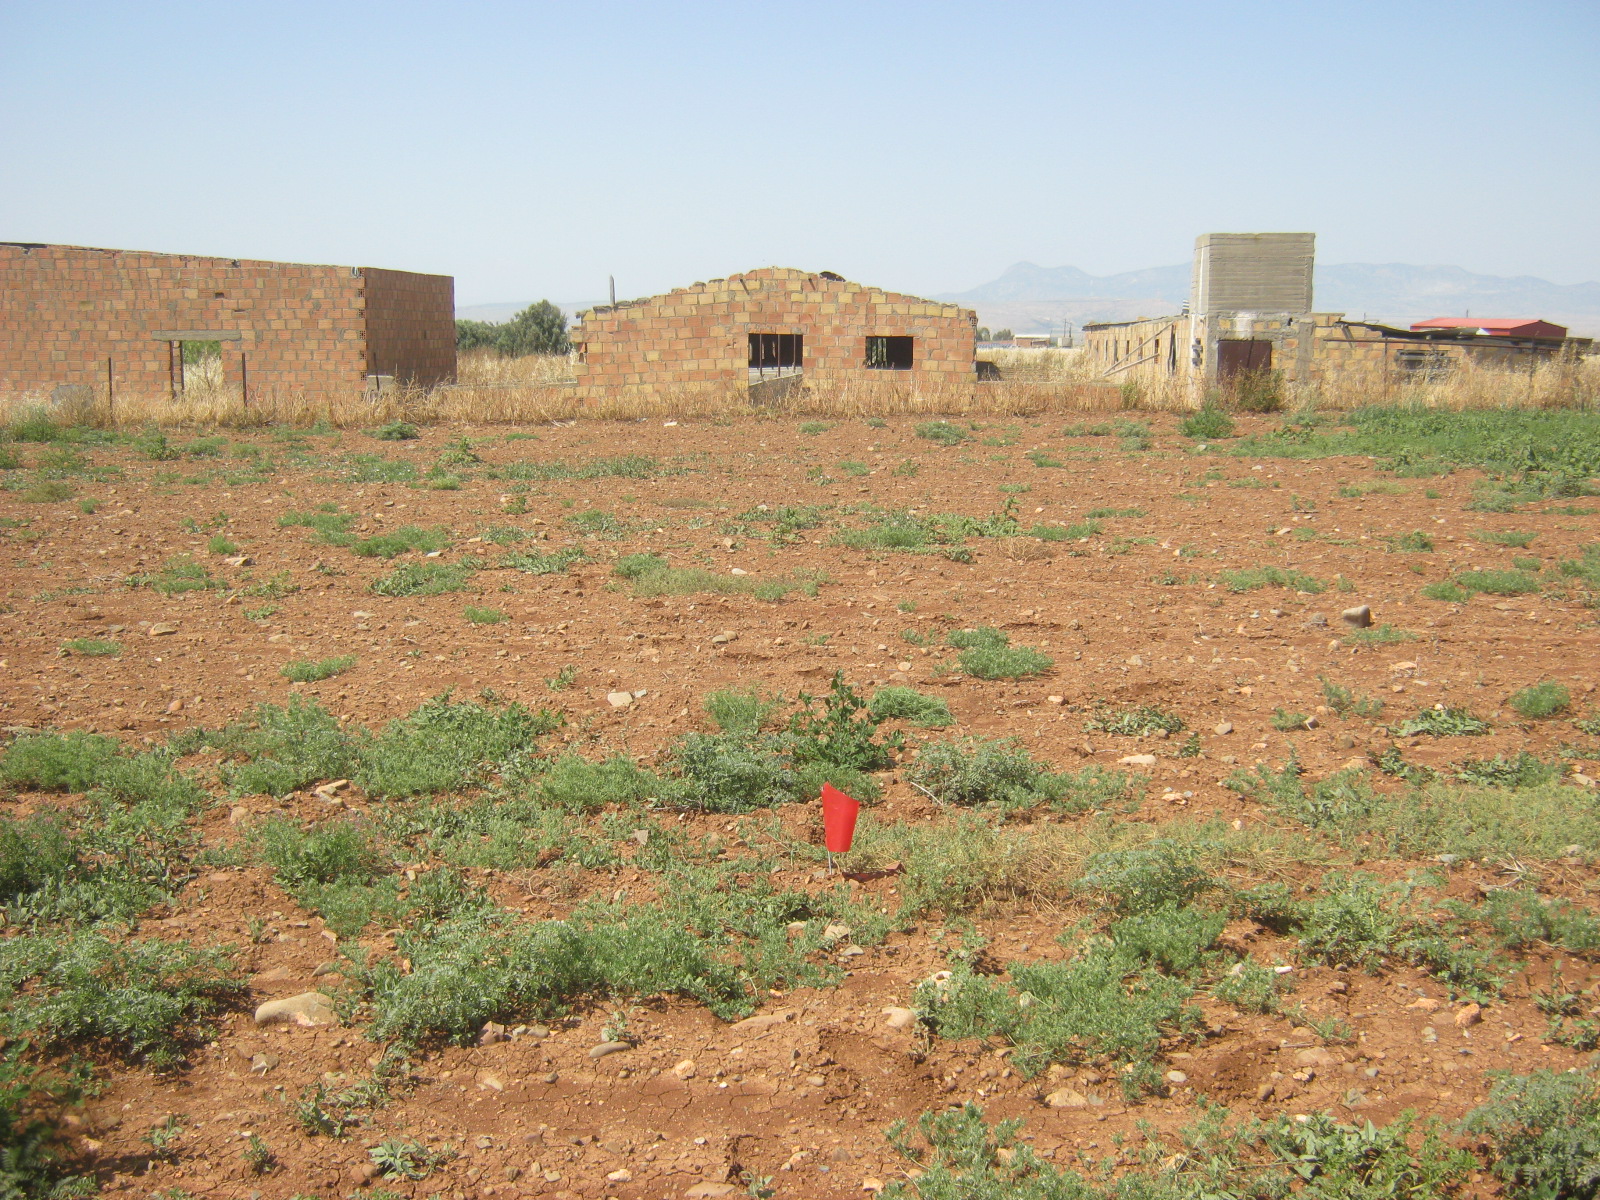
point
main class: Grassland
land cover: Spontaneously vegetated surfaces
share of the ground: 10 - 25 %
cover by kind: unconsolidated bare surface 75 %, herbaceous plants 25 %
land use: Fallow land
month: May
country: CY
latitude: 35.1061
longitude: 33.0996
